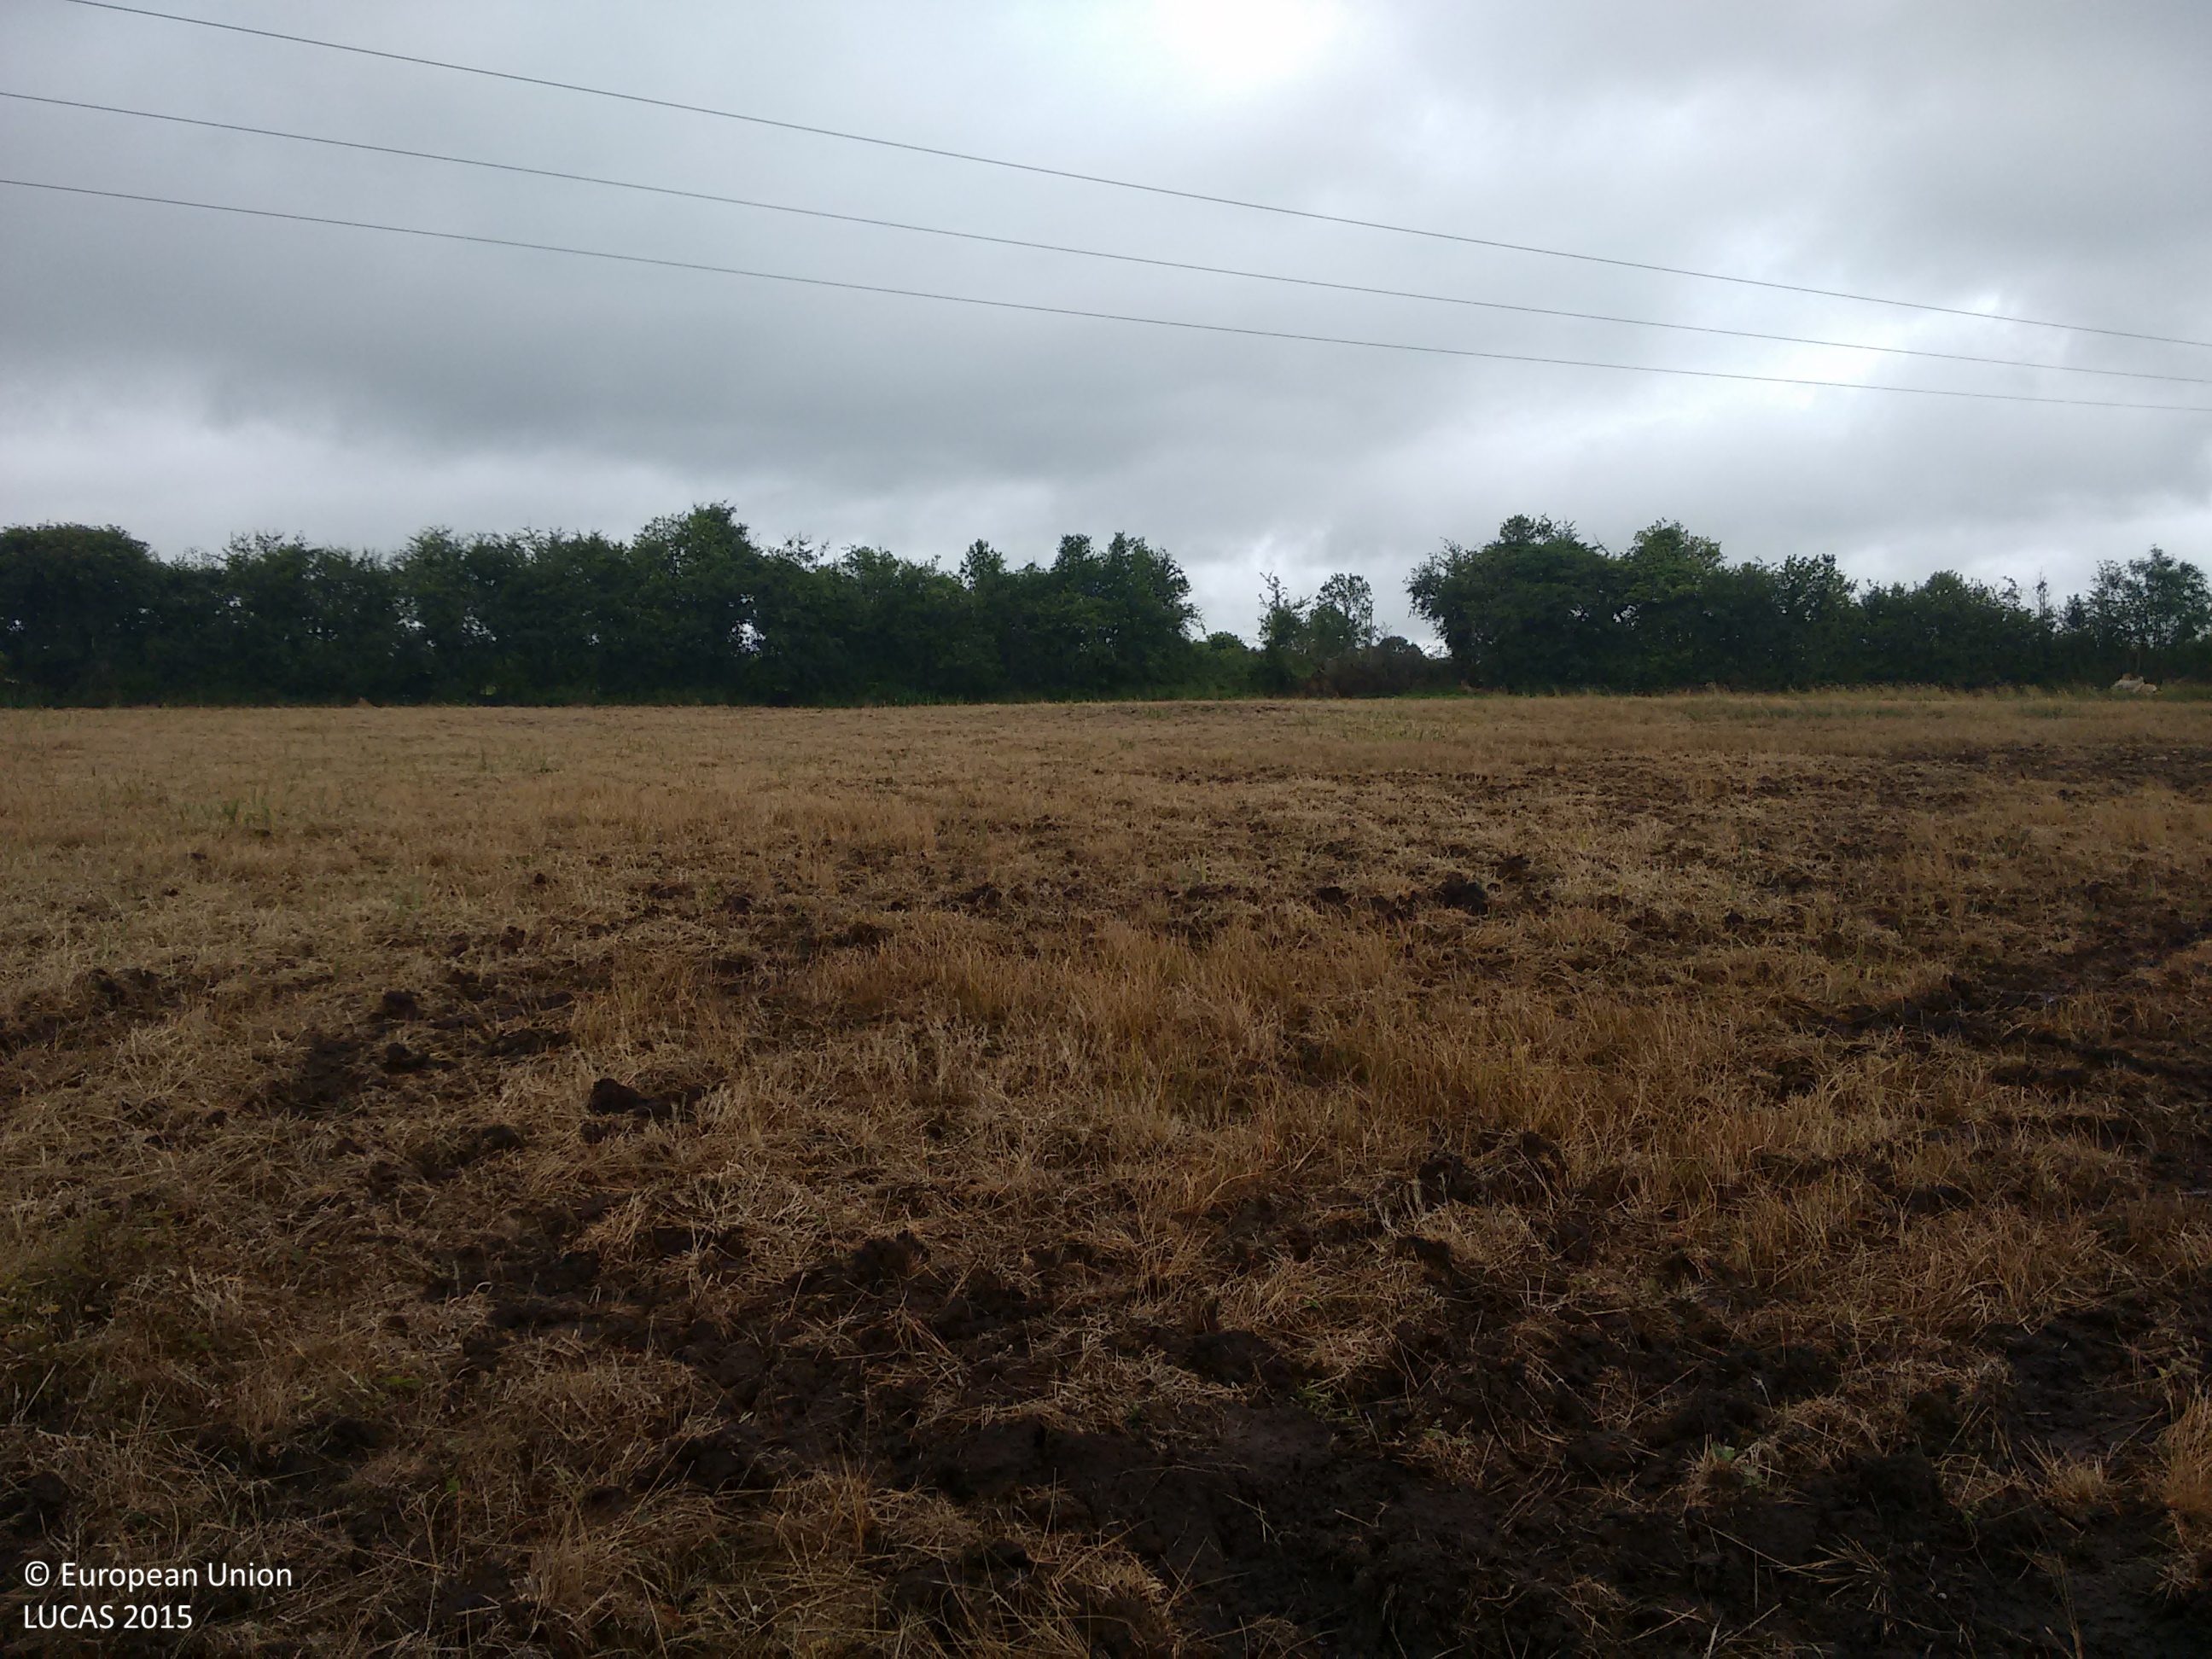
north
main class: Grassland
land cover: Spontaneously vegetated surfaces
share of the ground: 50 - 75 %
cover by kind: herbaceous plants 65 %, unconsolidated bare surface 35 %
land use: Fallow land
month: July
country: IE
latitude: 53.5892
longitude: -7.7355
